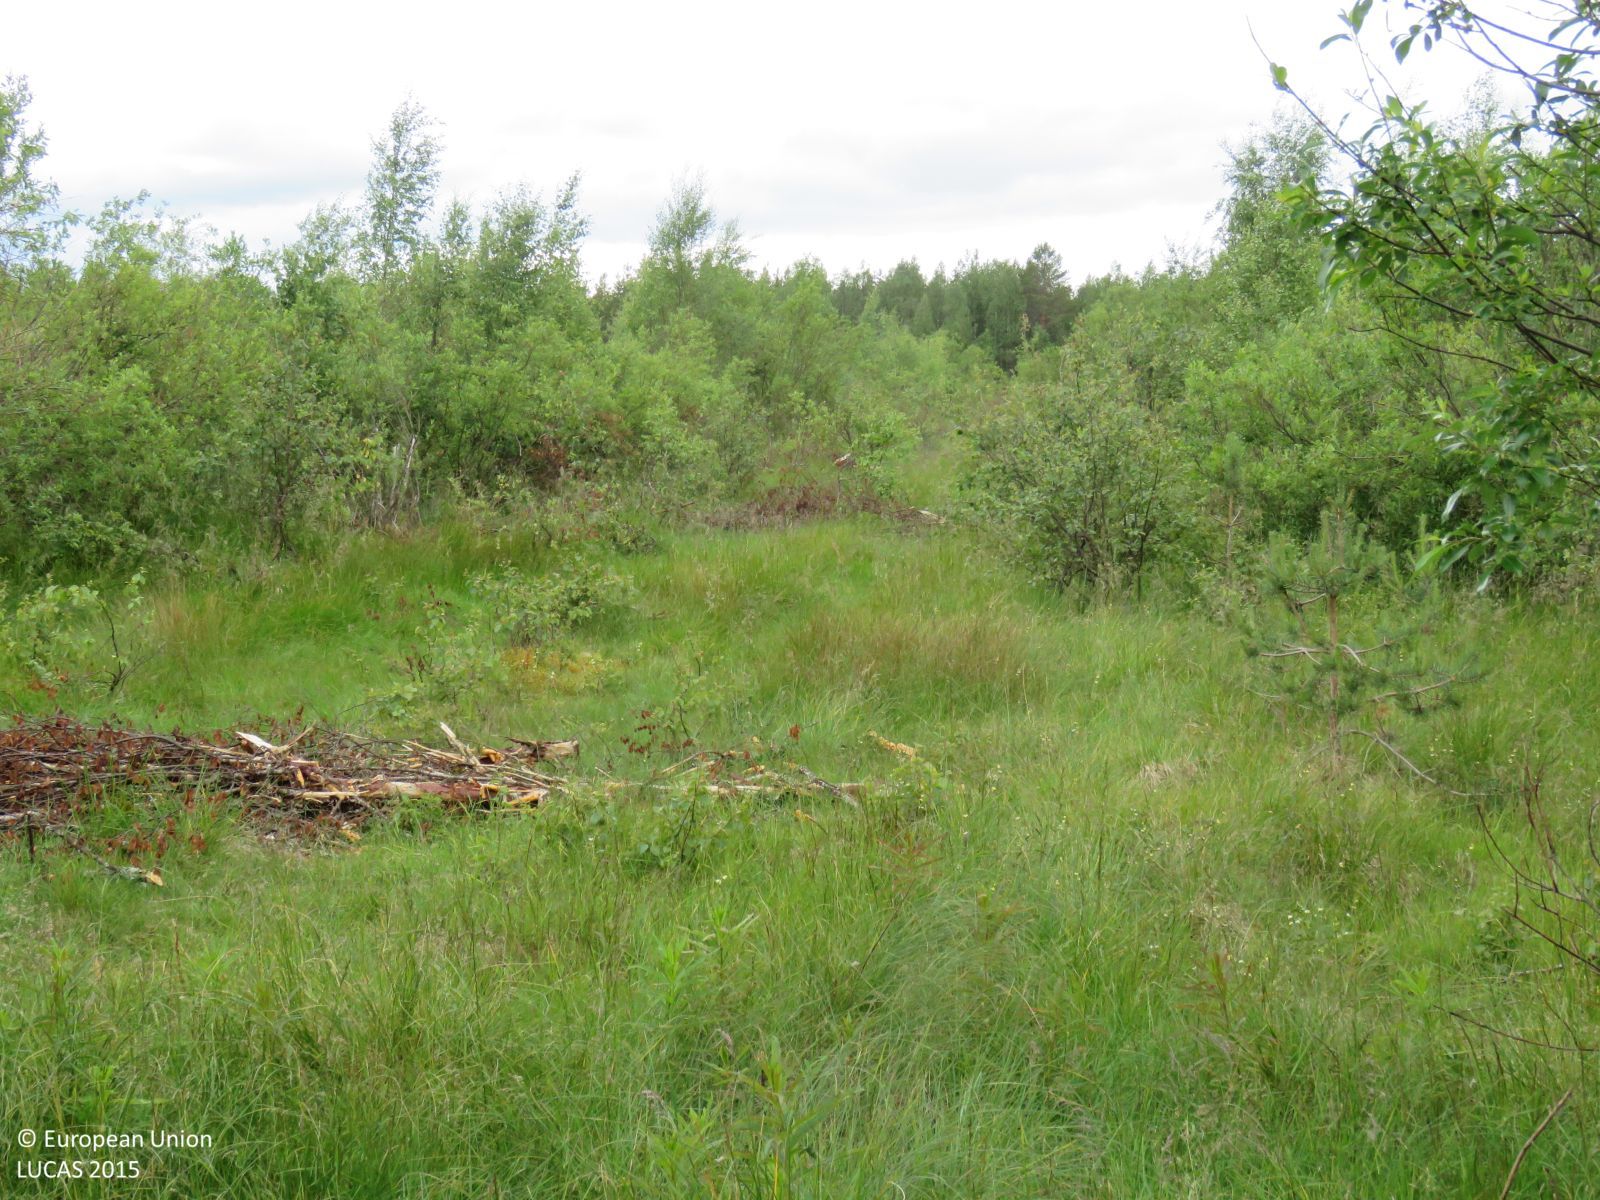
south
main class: Shrubland
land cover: Shrubland with sparse tree cover
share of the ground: 50 - 75 %
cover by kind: herbaceous plants 55 %, shrubs 40 %, broadleaved forest trees 5 %
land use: Semi-natural and natural areas not in use
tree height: < 5 m
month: July
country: FI
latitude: 64.4516
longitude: 26.6832
